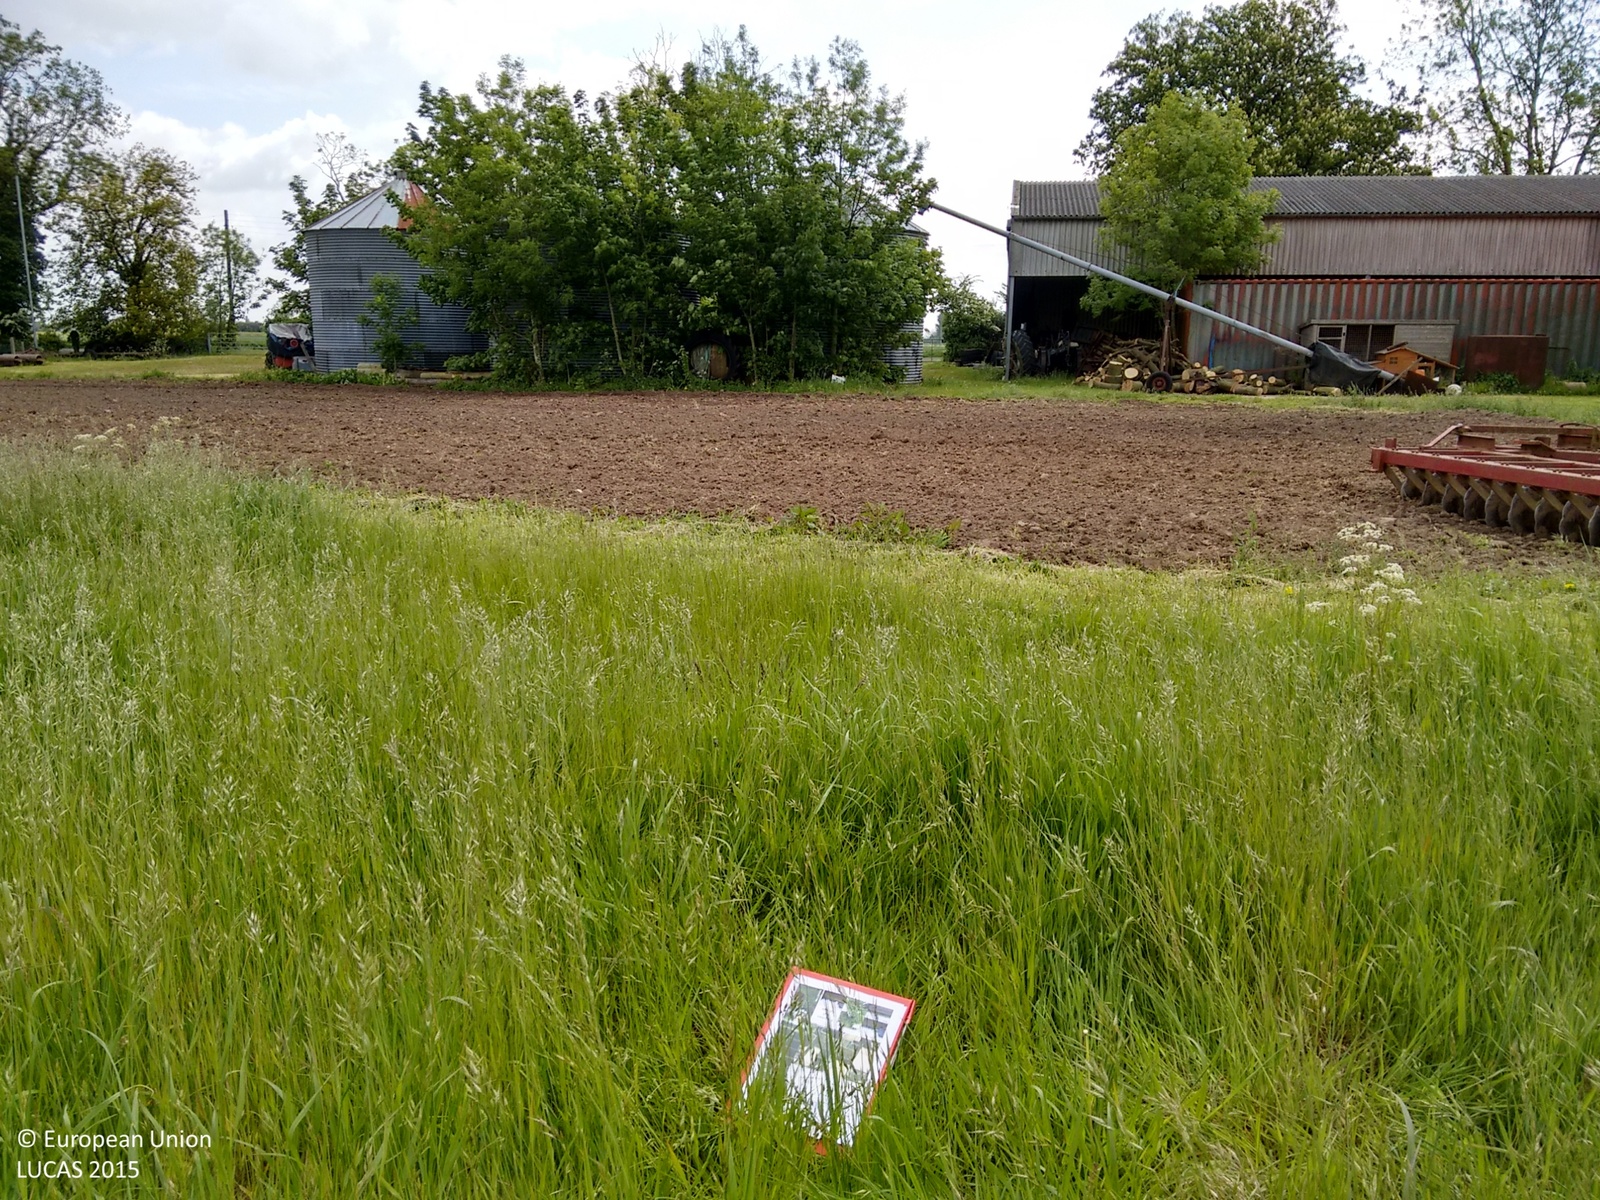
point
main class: Grassland
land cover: Grassland without tree/shrub cover
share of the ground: > 75 %
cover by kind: herbaceous plants 100 %
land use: Agriculture (excluding fallow land and kitchen gardens)
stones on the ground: < 10 %
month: May
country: GB
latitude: 52.7512
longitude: -0.0032
